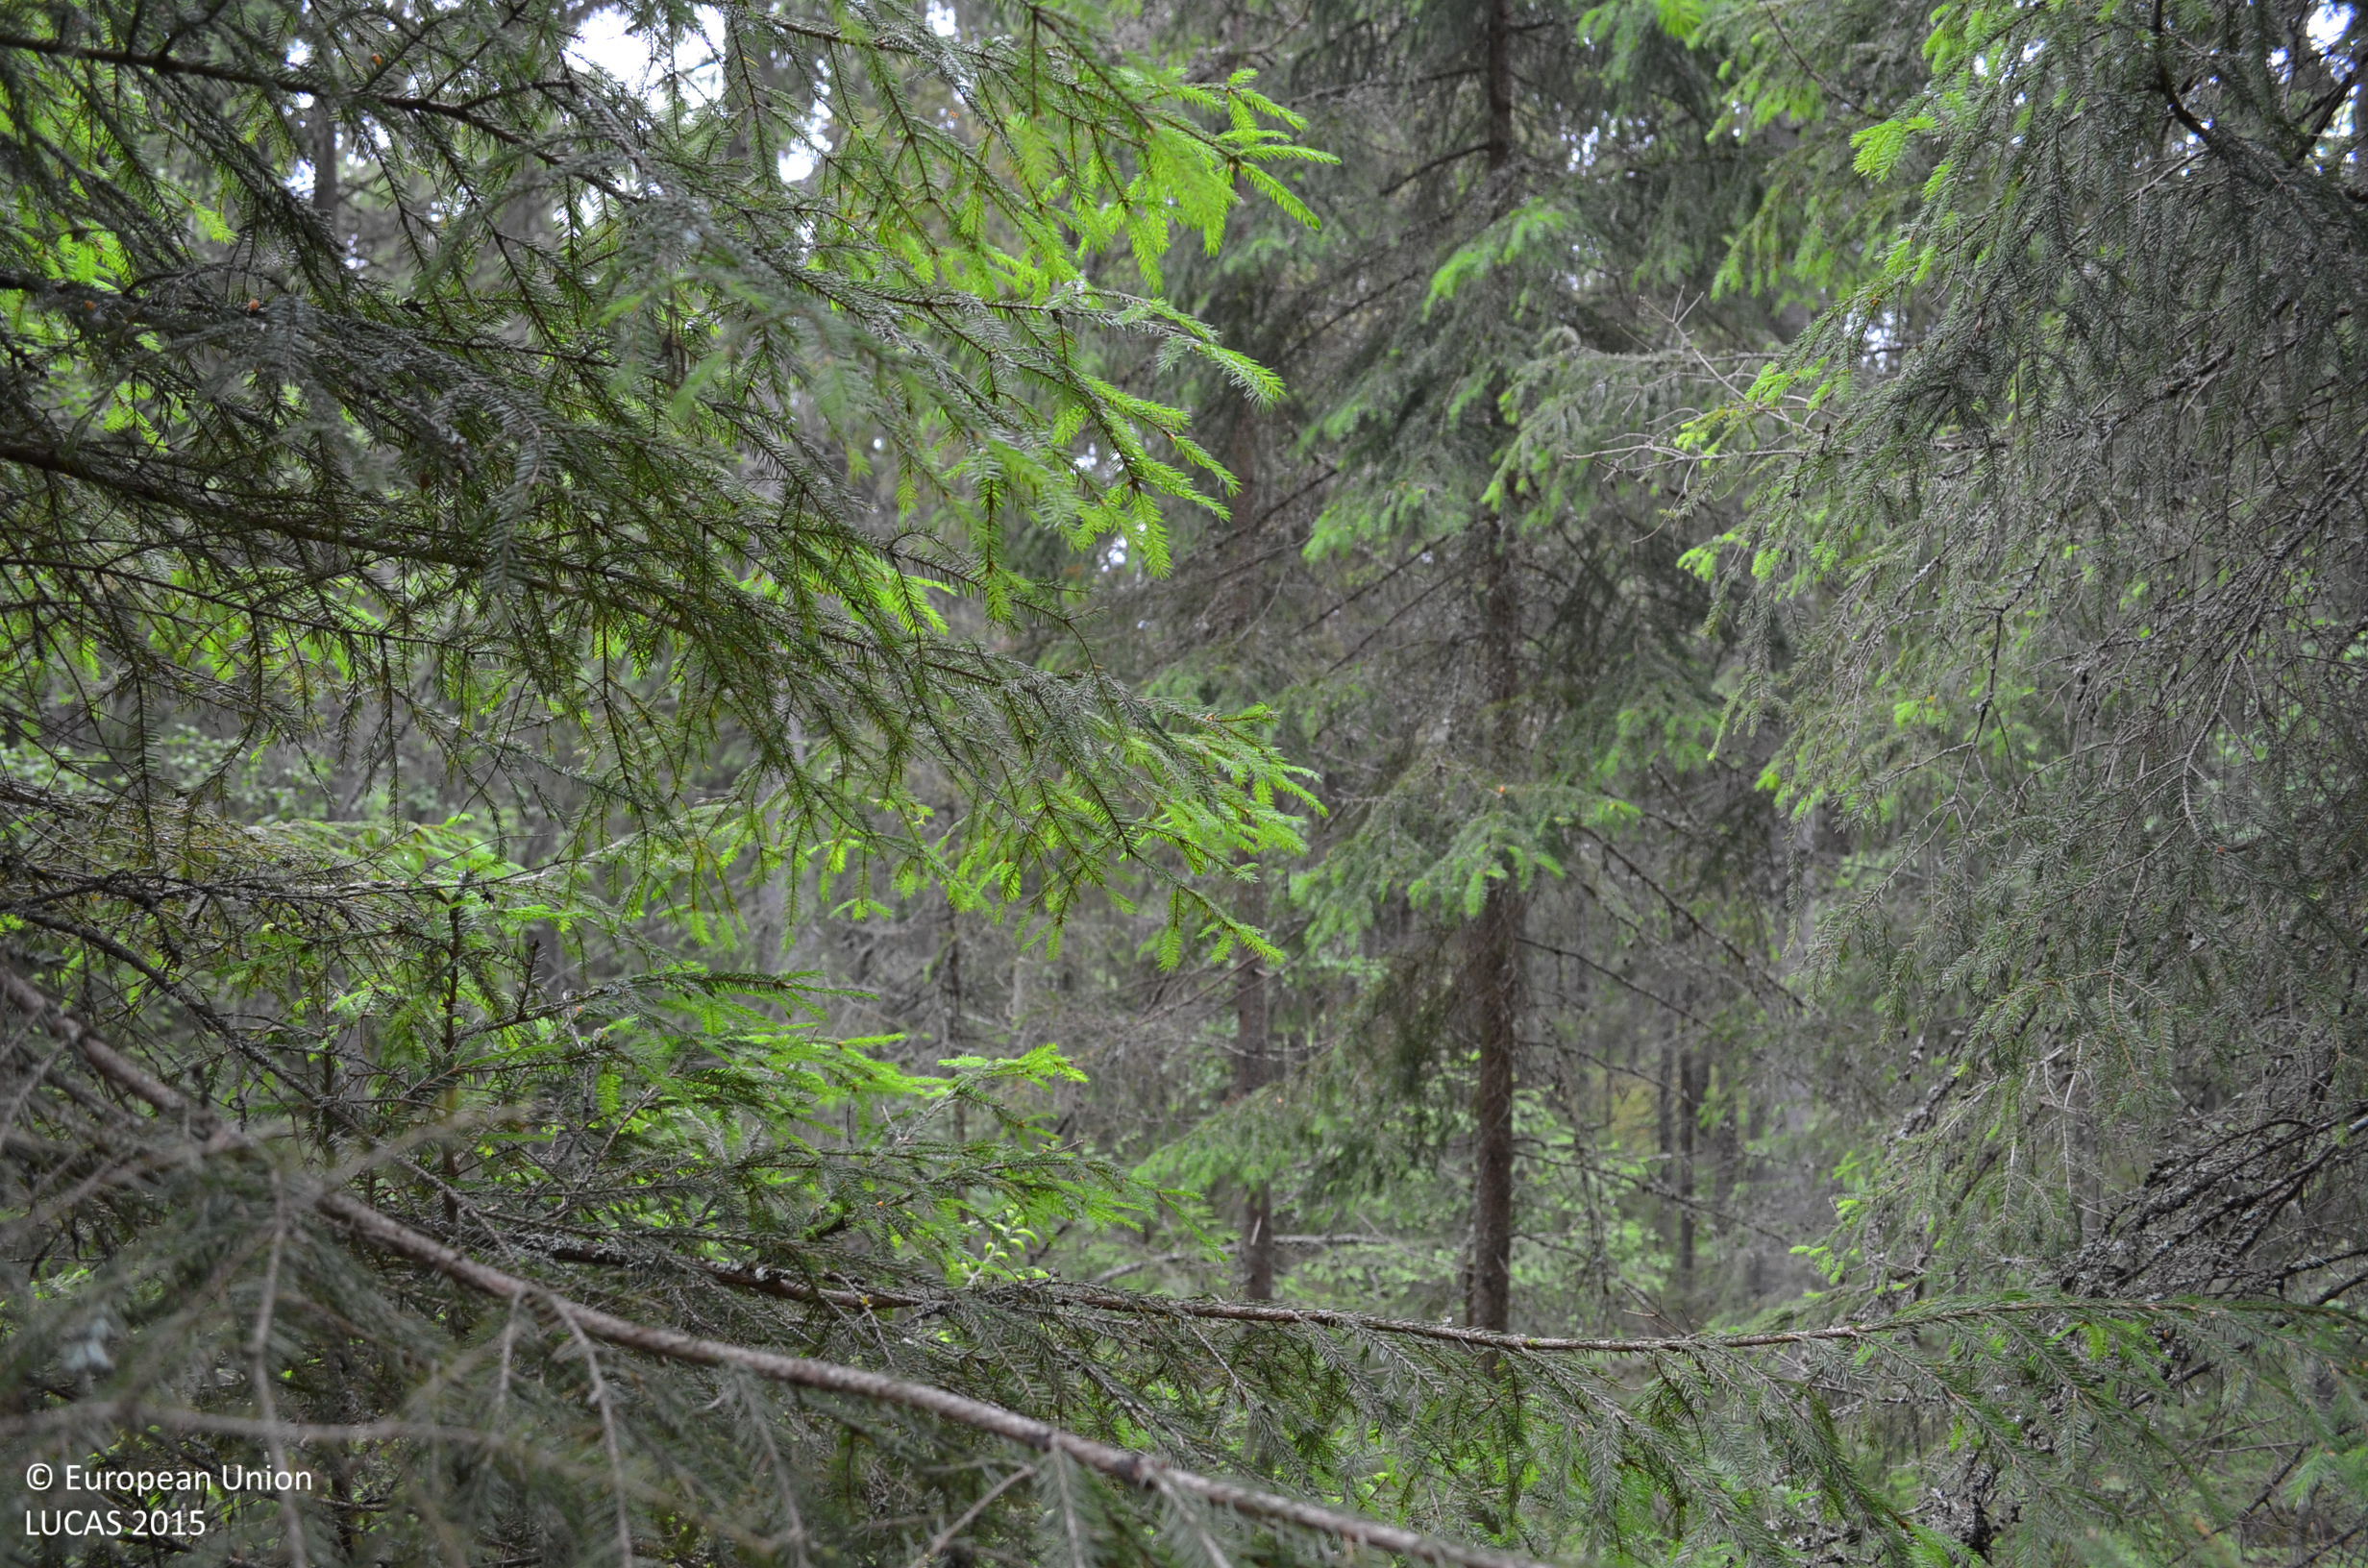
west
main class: Woodland
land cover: Spruce dominated coniferous woodland
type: boreal forest
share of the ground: > 75 %
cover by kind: coniferous forest trees 75 %, broadleaved forest trees 10 %, shrubs 5 %, herbaceous plants 5 %, lichens and mosses 5 %
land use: Forestry
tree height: > 5 m
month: June
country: FI
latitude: 61.7390
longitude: 23.1537
